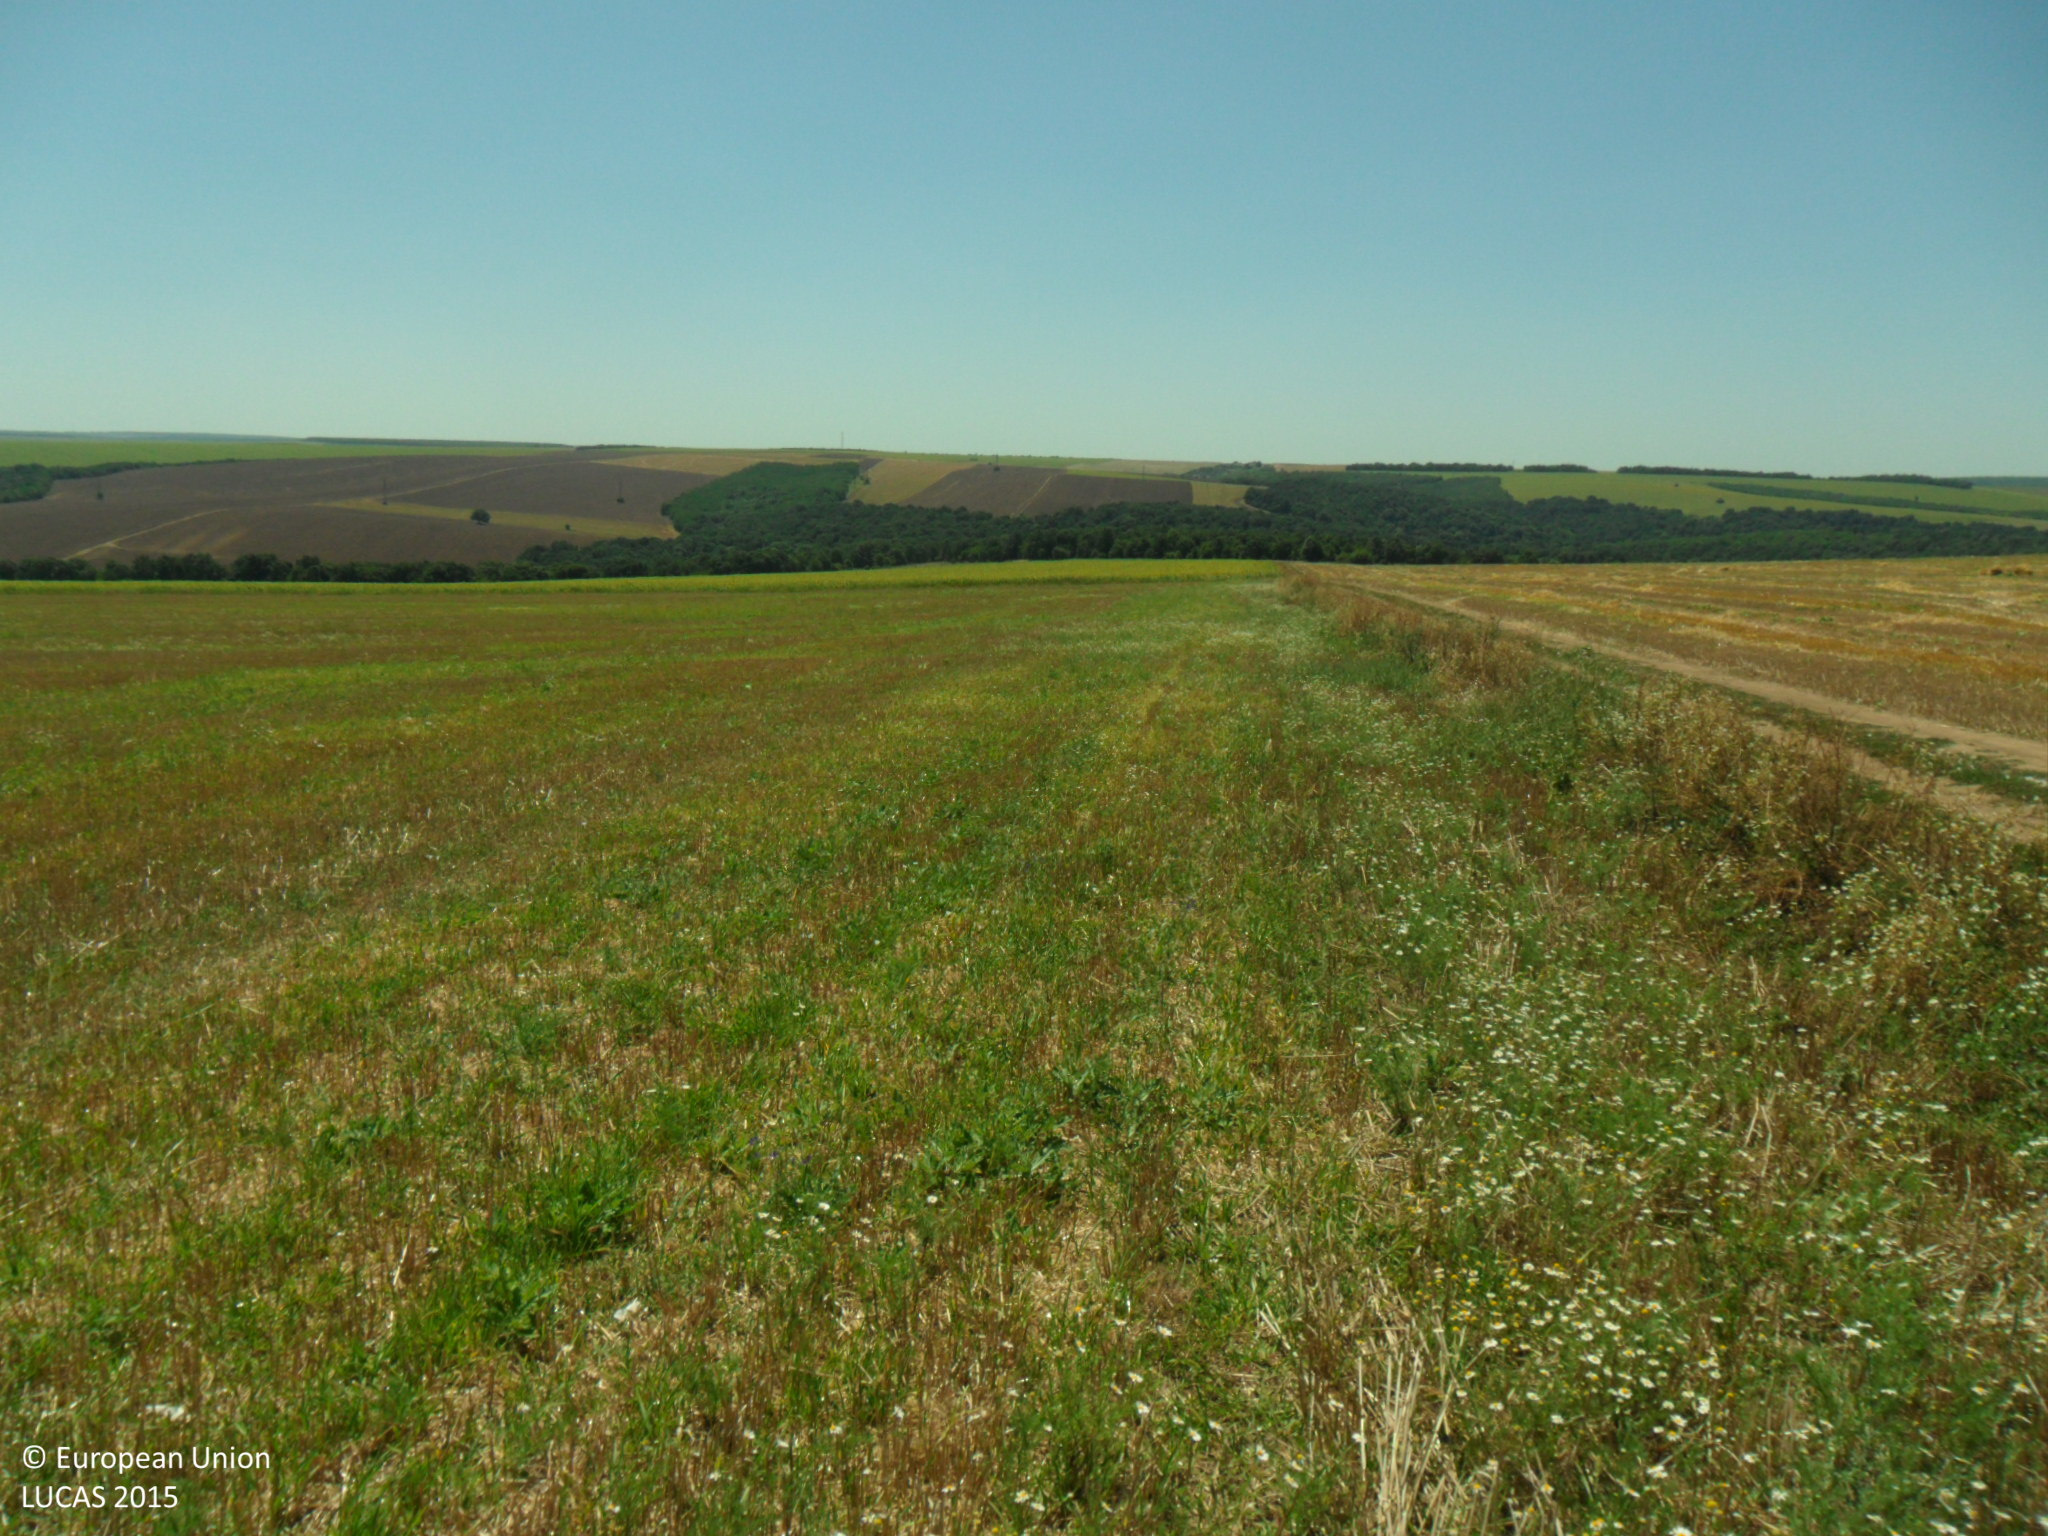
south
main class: Cropland
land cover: Common wheat
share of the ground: > 75 %
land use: Agriculture (excluding fallow land and kitchen gardens)
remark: Harvested field
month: July
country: BG
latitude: 43.7889
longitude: 26.3970
